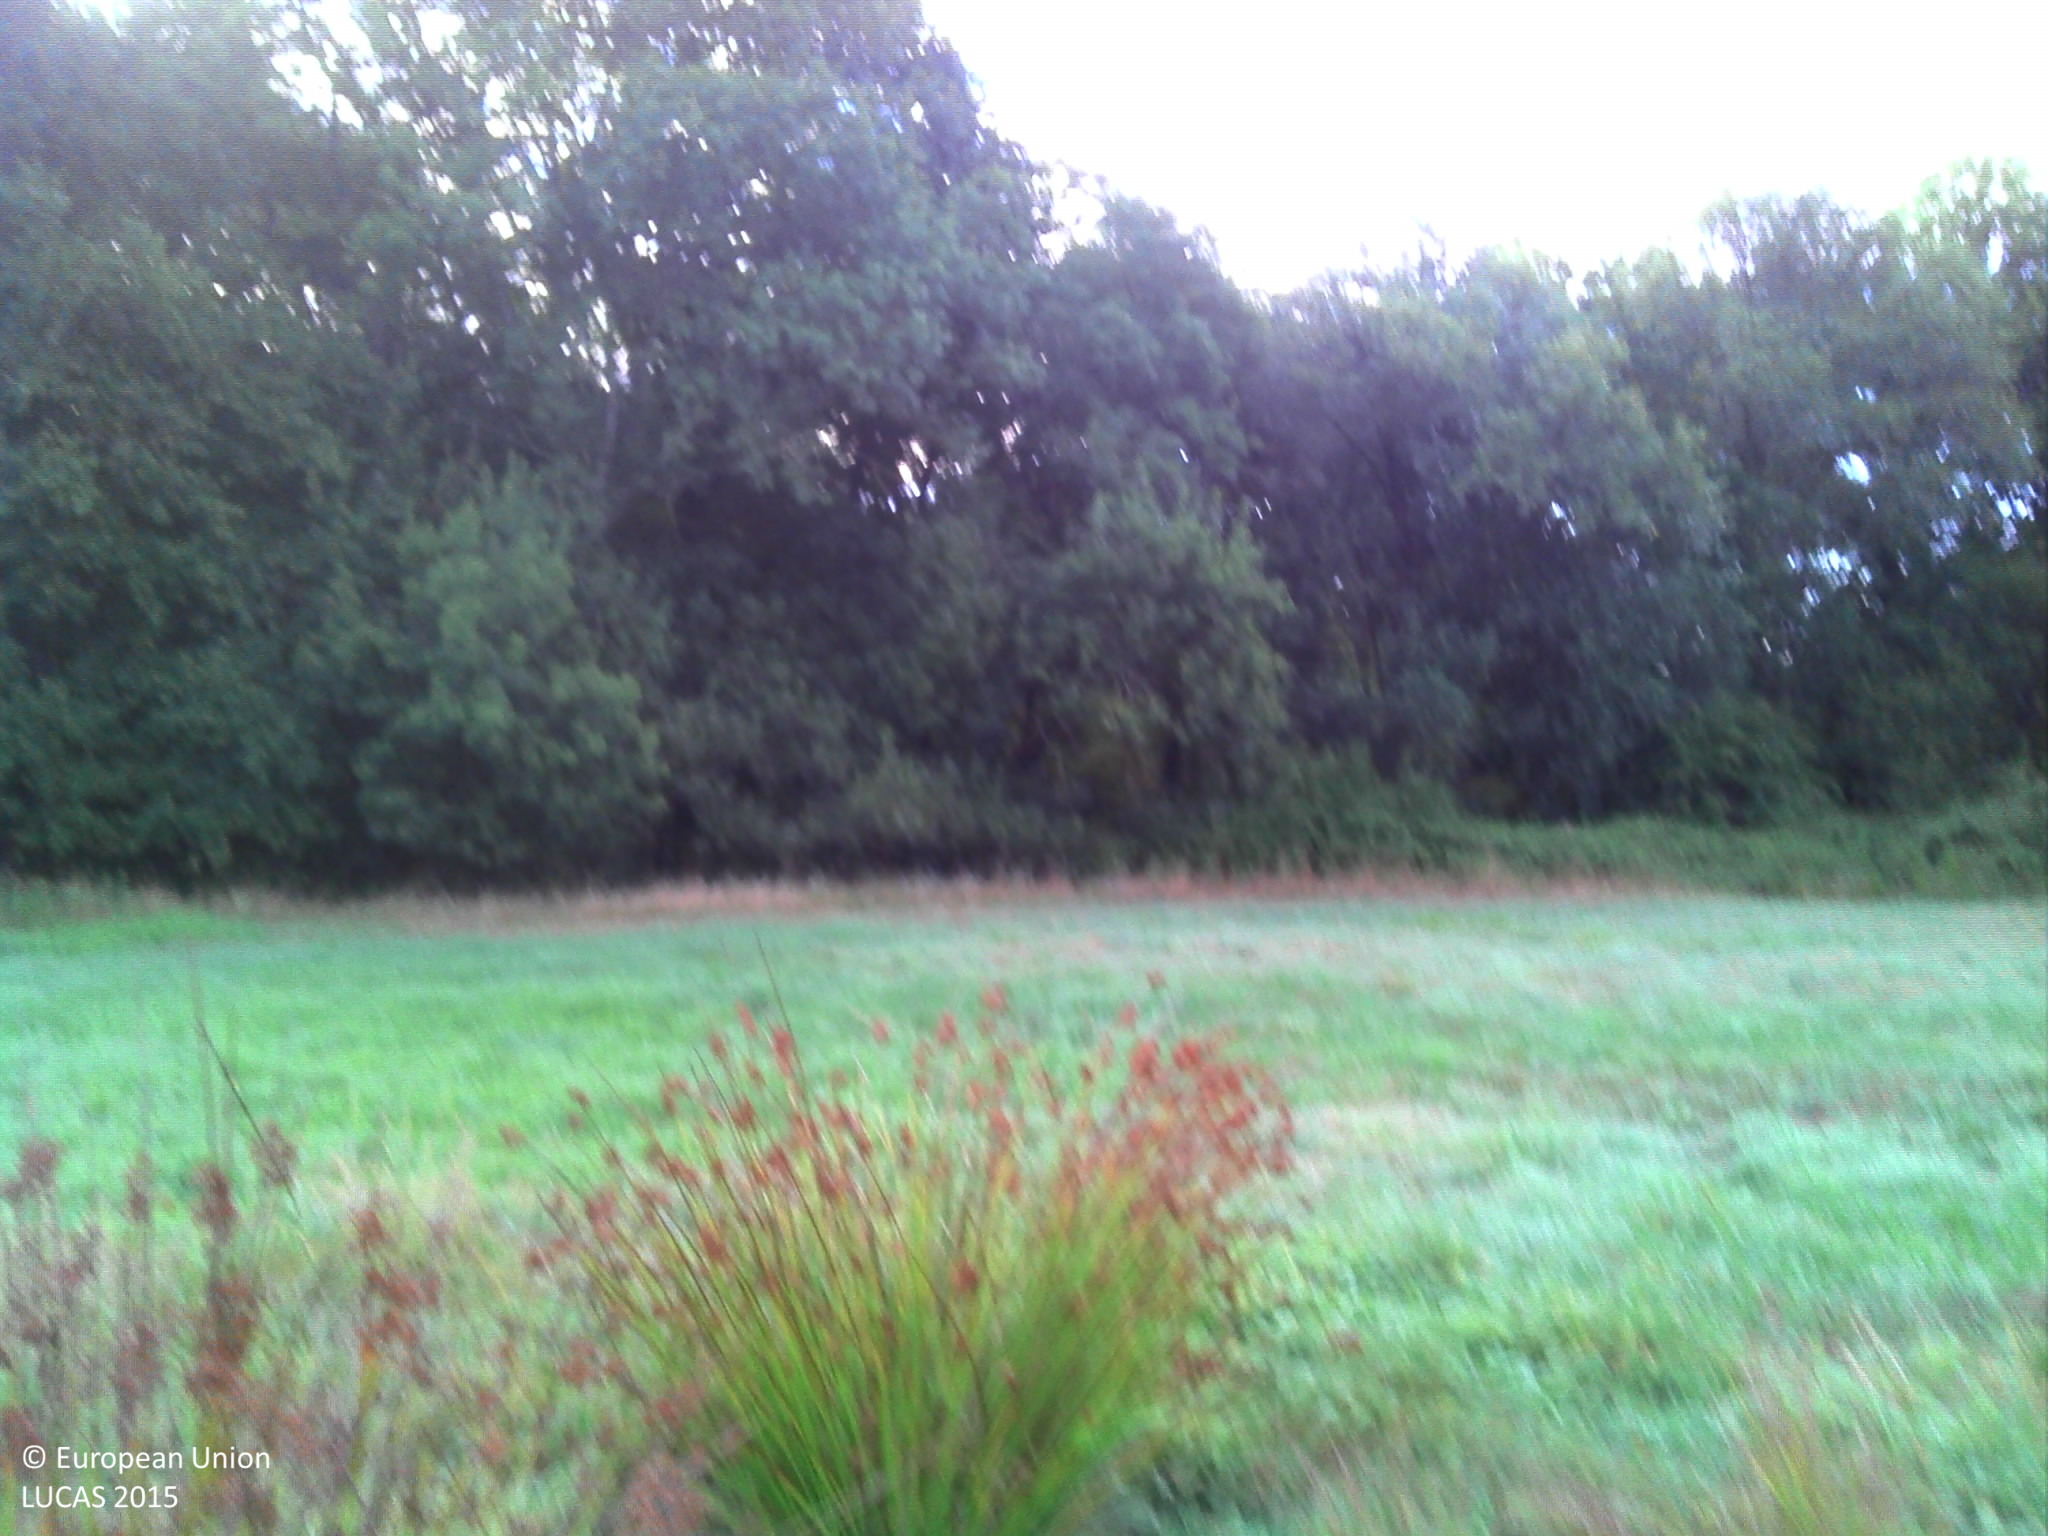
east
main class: Grassland
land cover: Grassland without tree/shrub cover
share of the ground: > 75 %
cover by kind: herbaceous plants 100 %
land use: Agriculture (excluding fallow land and kitchen gardens)
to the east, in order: Grassland without tree/shrub cover; Broadleaved woodland; Rivers and streams; Broadleaved woodland; Ditches and canals; Broadleaved woodland; Fences; Broadleaved woodland; Tracks; Broadleaved woodland; Grassland without tree/shrub cover
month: August
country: FR
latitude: 47.2030
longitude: 2.1629
